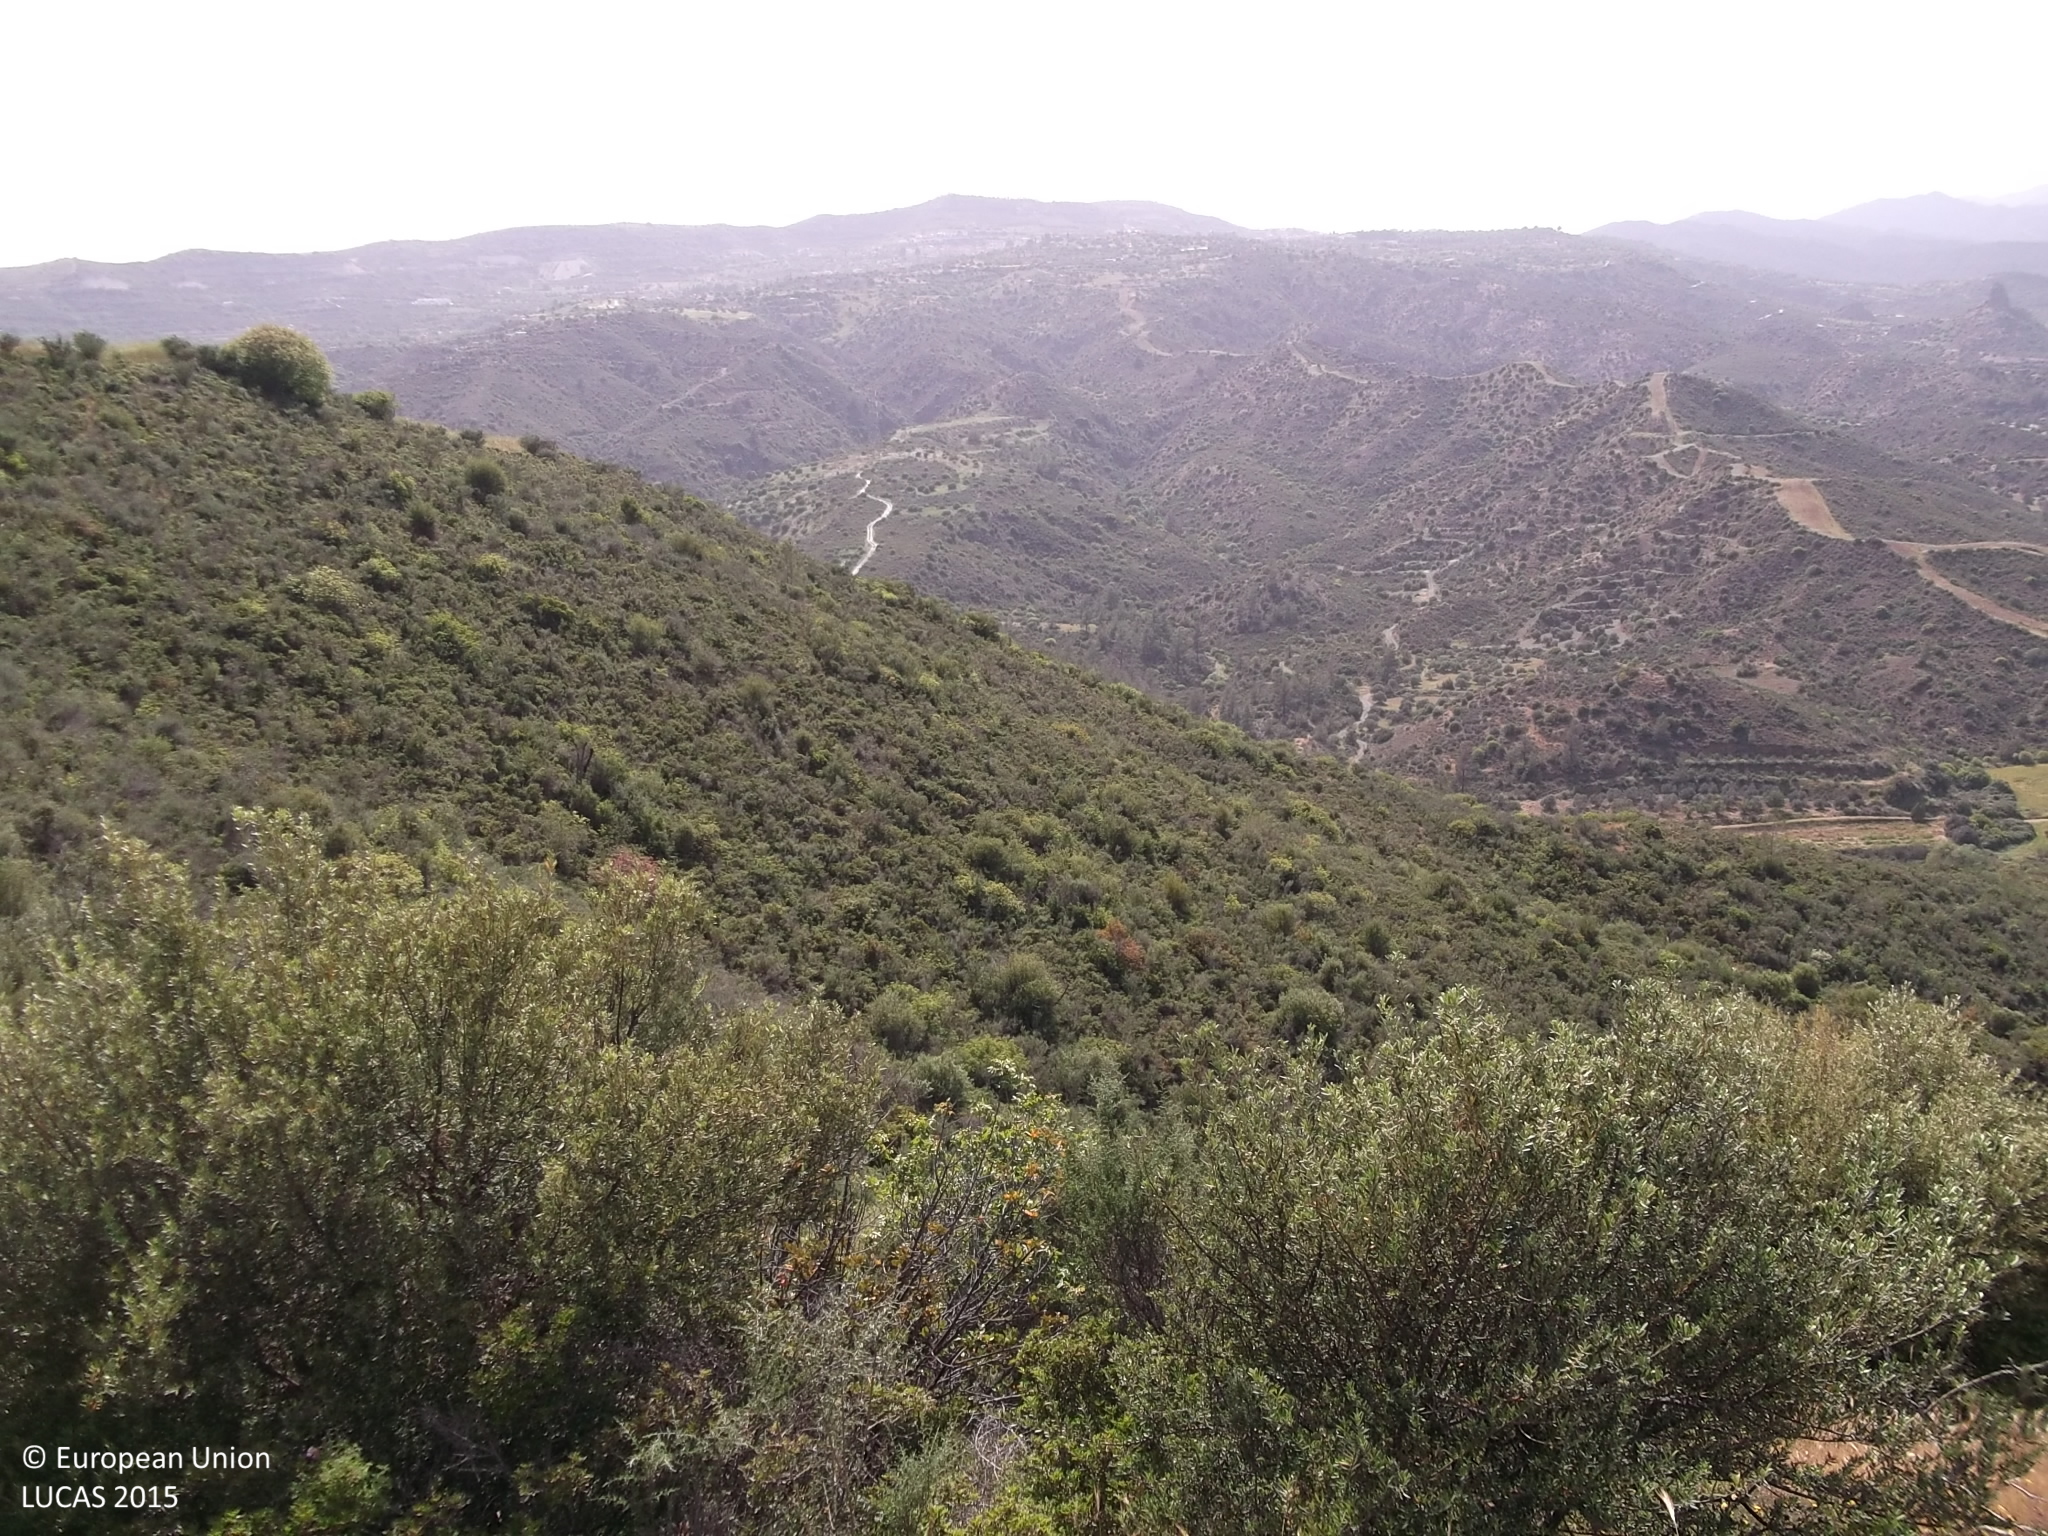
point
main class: Shrubland
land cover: Shrubland with sparse tree cover
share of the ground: > 75 %
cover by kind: shrubs 95 %, broadleaved forest trees 5 %
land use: Semi-natural and natural areas not in use
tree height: < 5 m
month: April
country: CY
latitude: 34.8744
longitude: 33.3434
